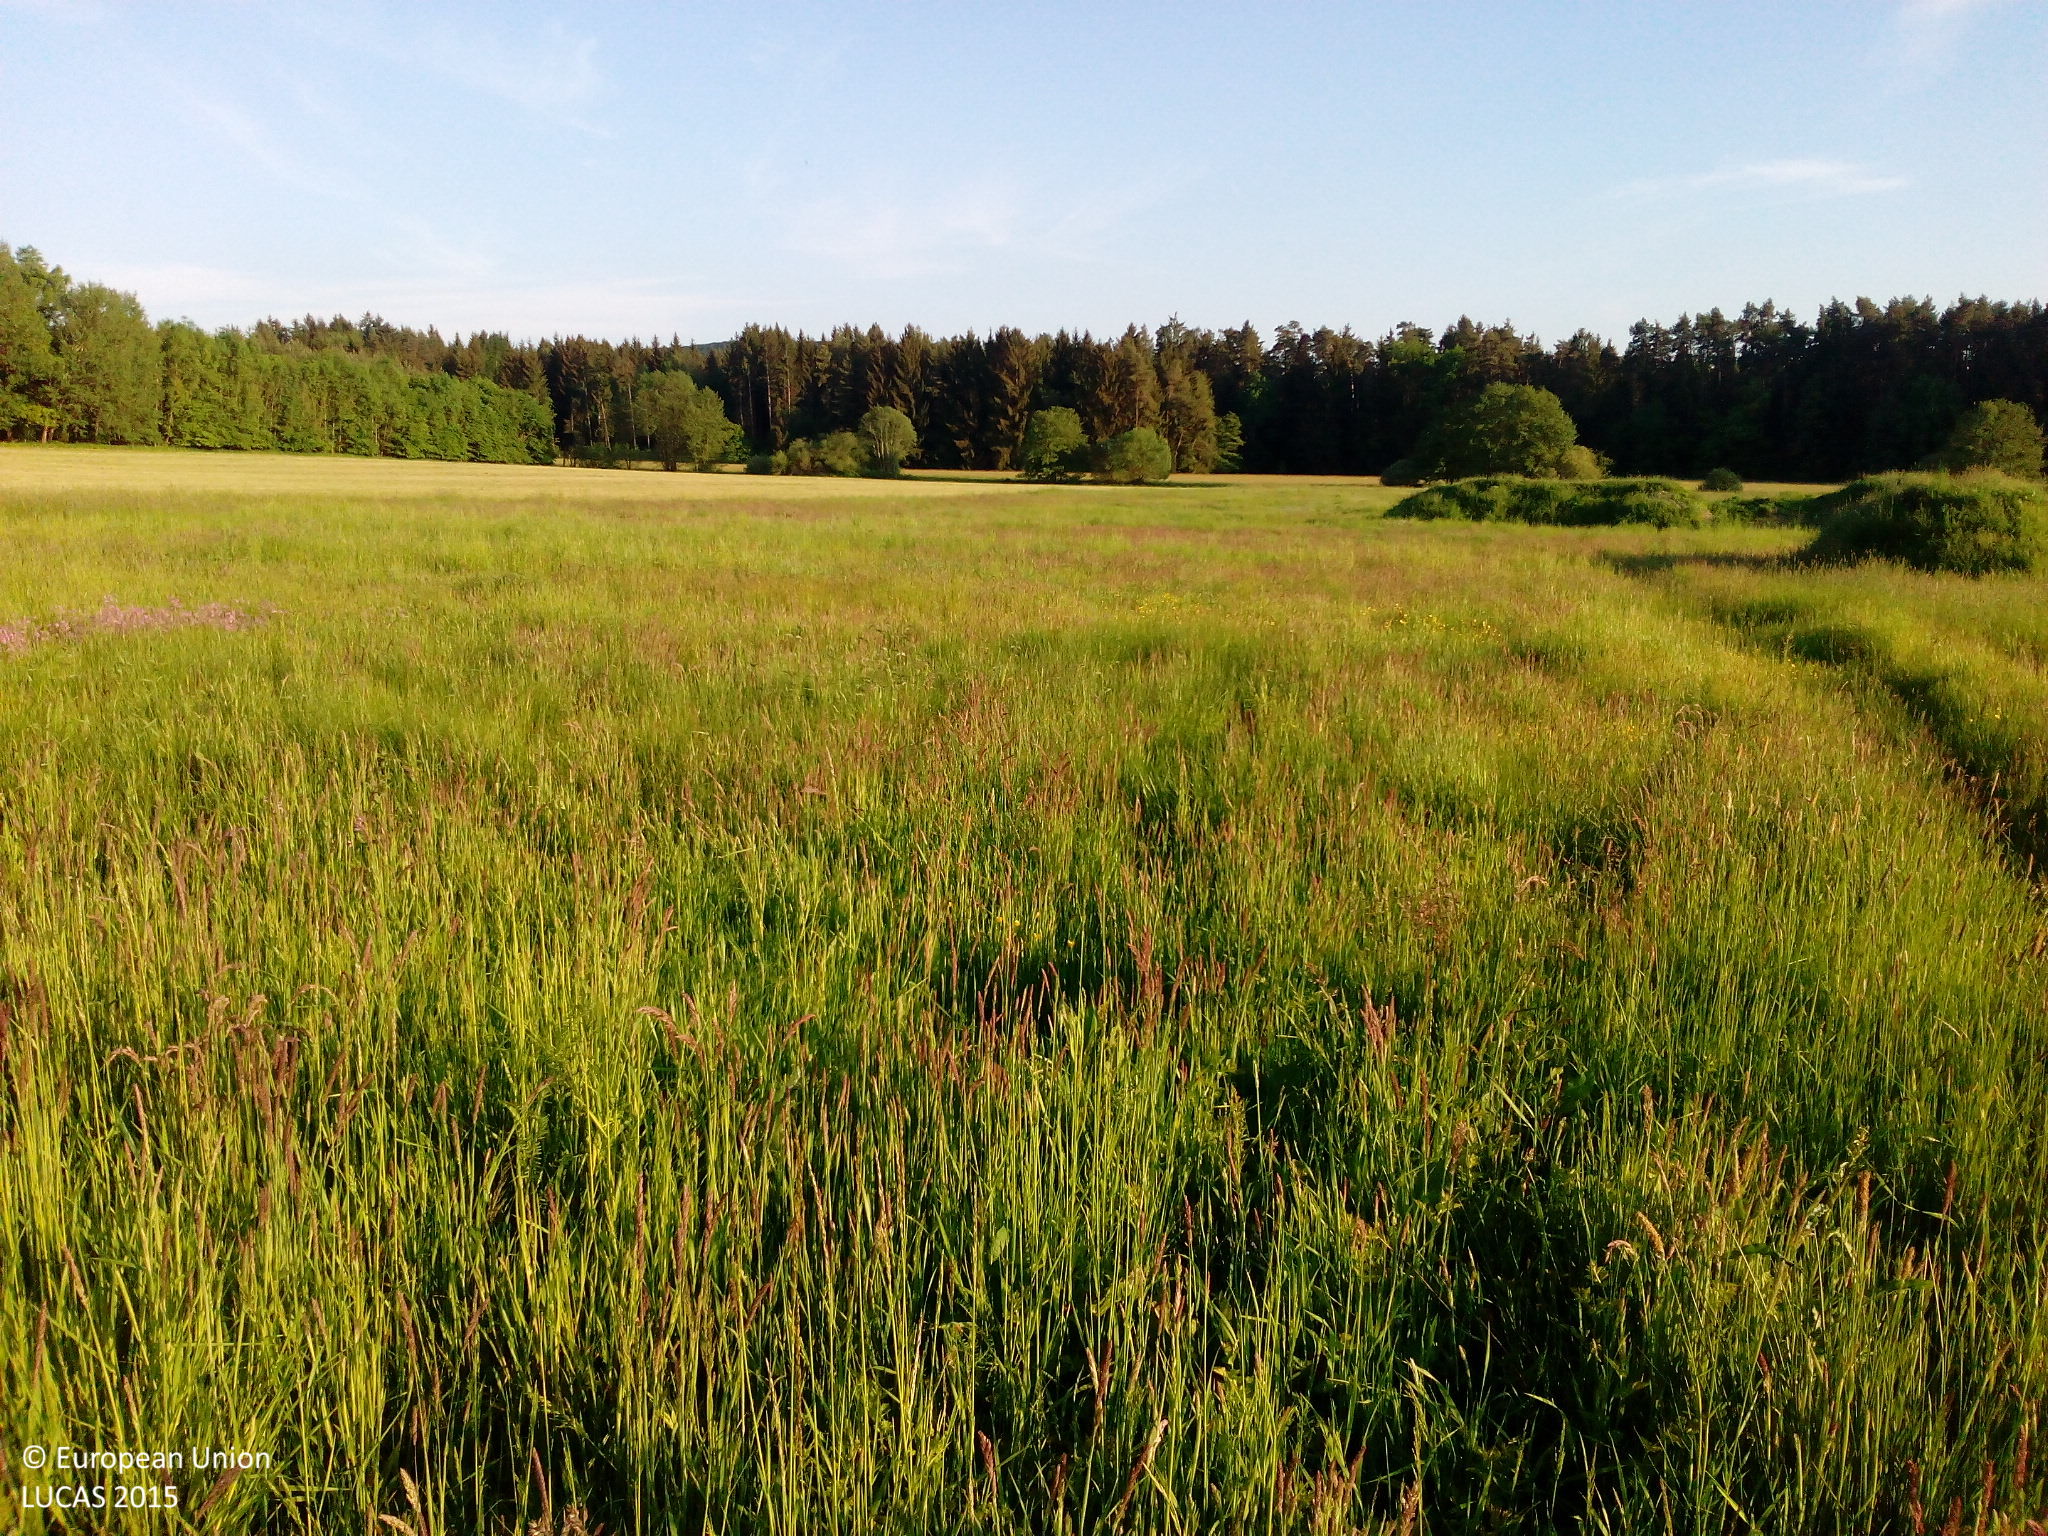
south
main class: Grassland
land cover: Grassland without tree/shrub cover
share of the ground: > 75 %
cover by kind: herbaceous plants 95 %, unconsolidated bare surface 5 %
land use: Agriculture (excluding fallow land and kitchen gardens)
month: May
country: DE
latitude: 49.2214
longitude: 11.4686
